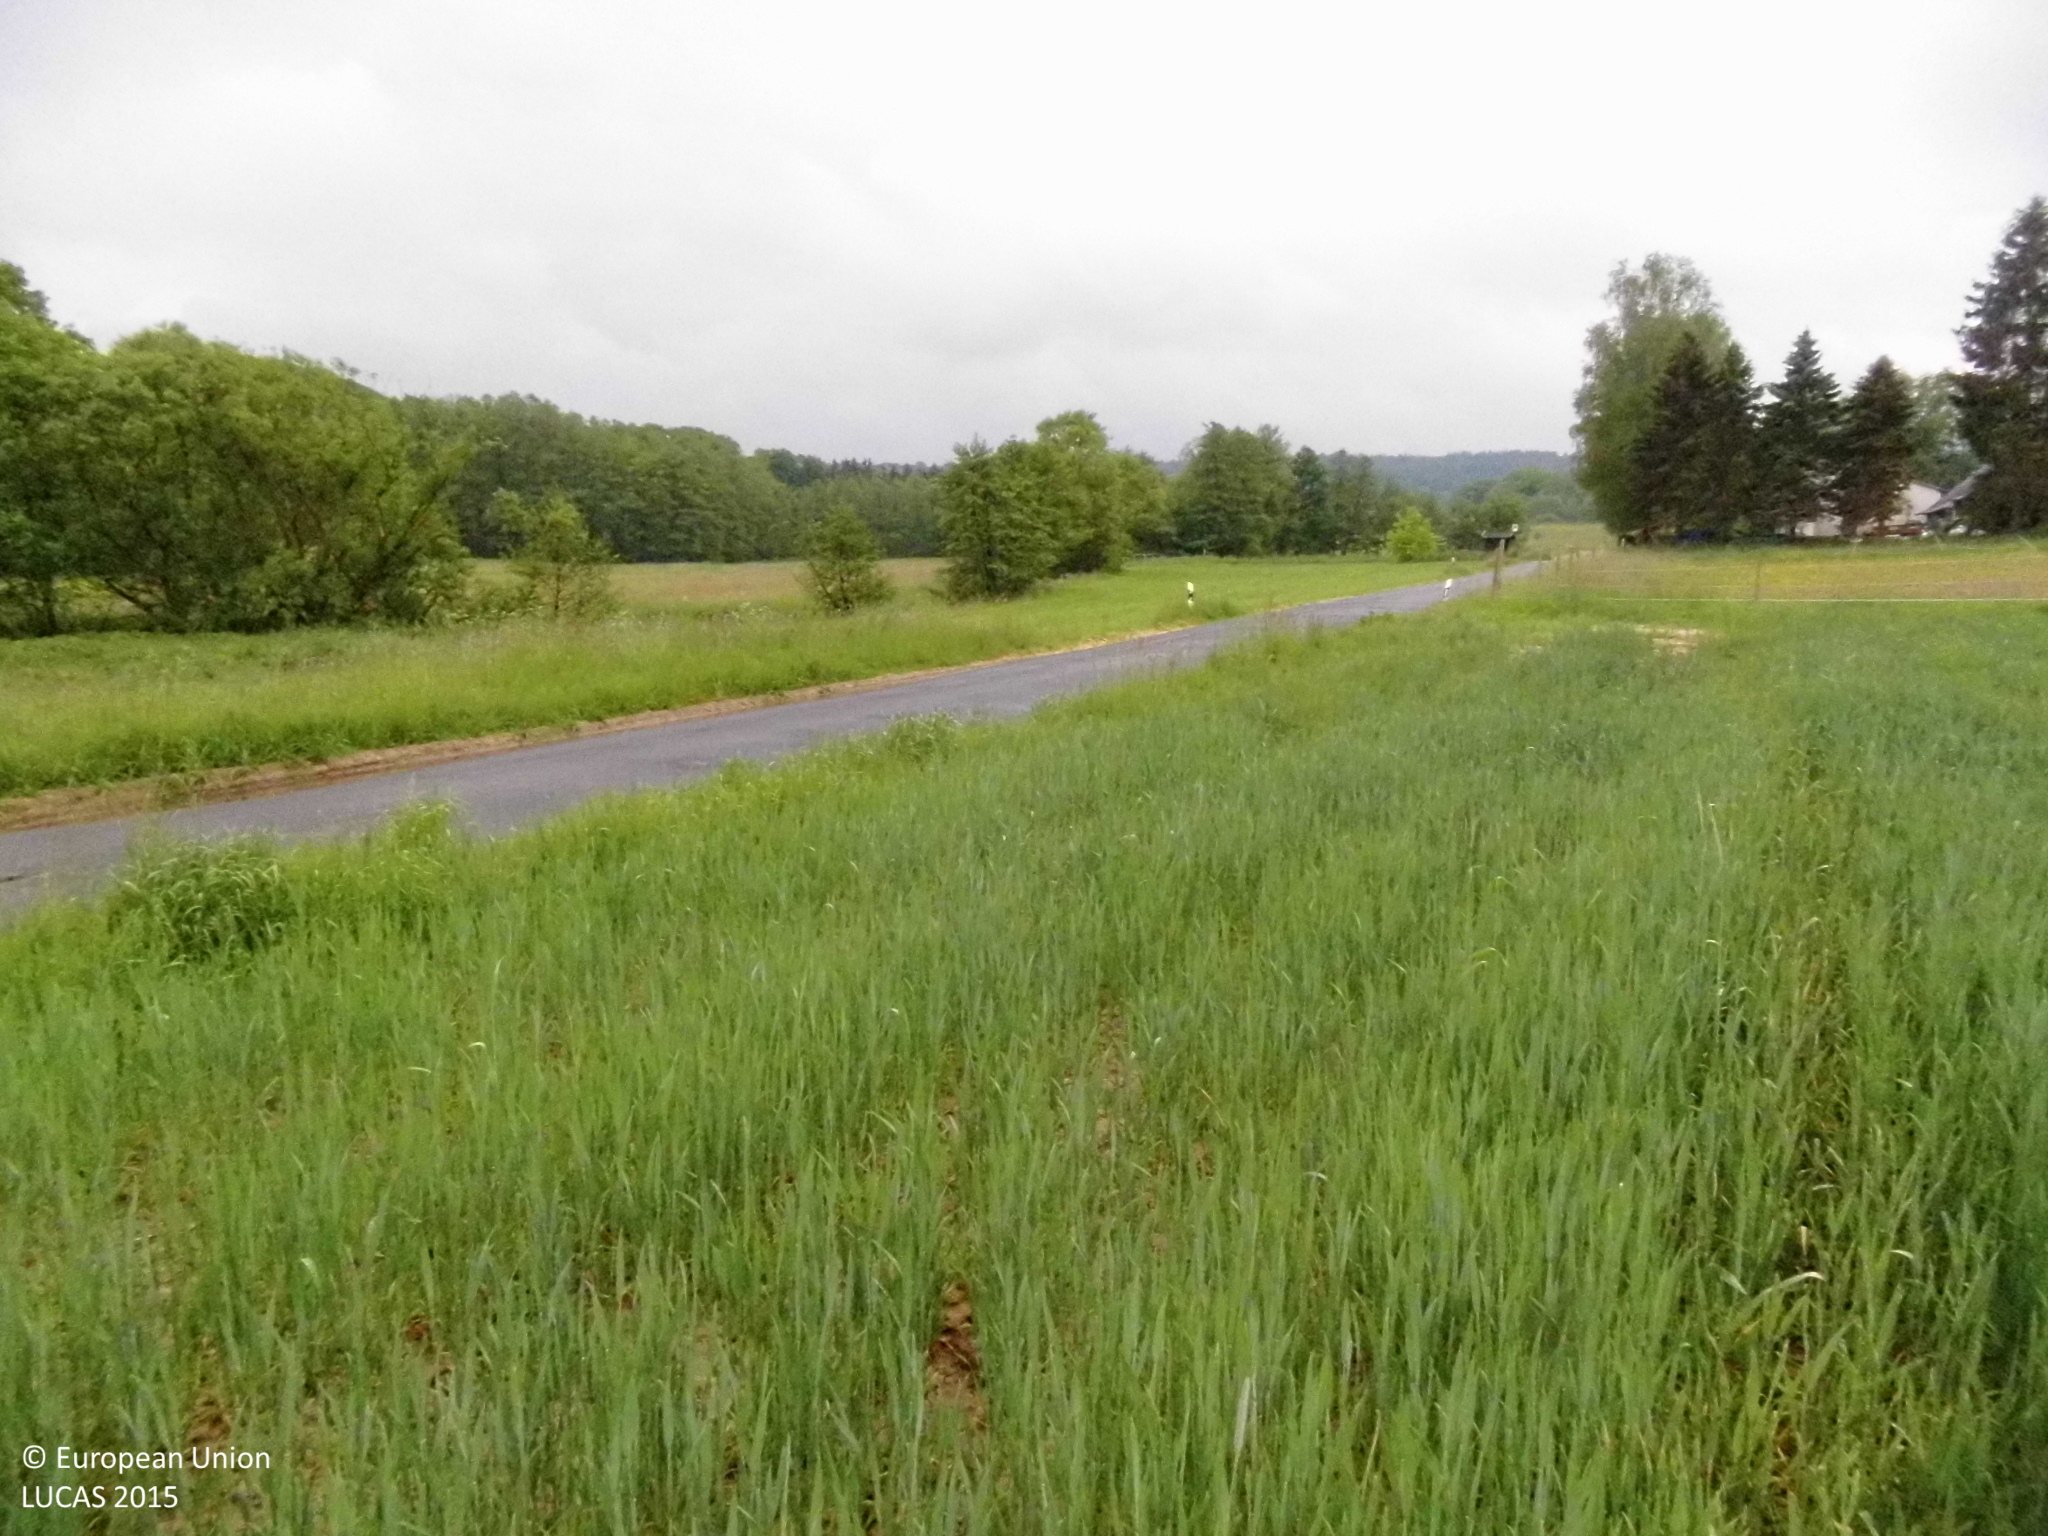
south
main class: Cropland
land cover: Common wheat
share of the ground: > 75 %
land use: Agriculture (excluding fallow land and kitchen gardens)
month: May
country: DE
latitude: 50.6970
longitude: 7.5227
